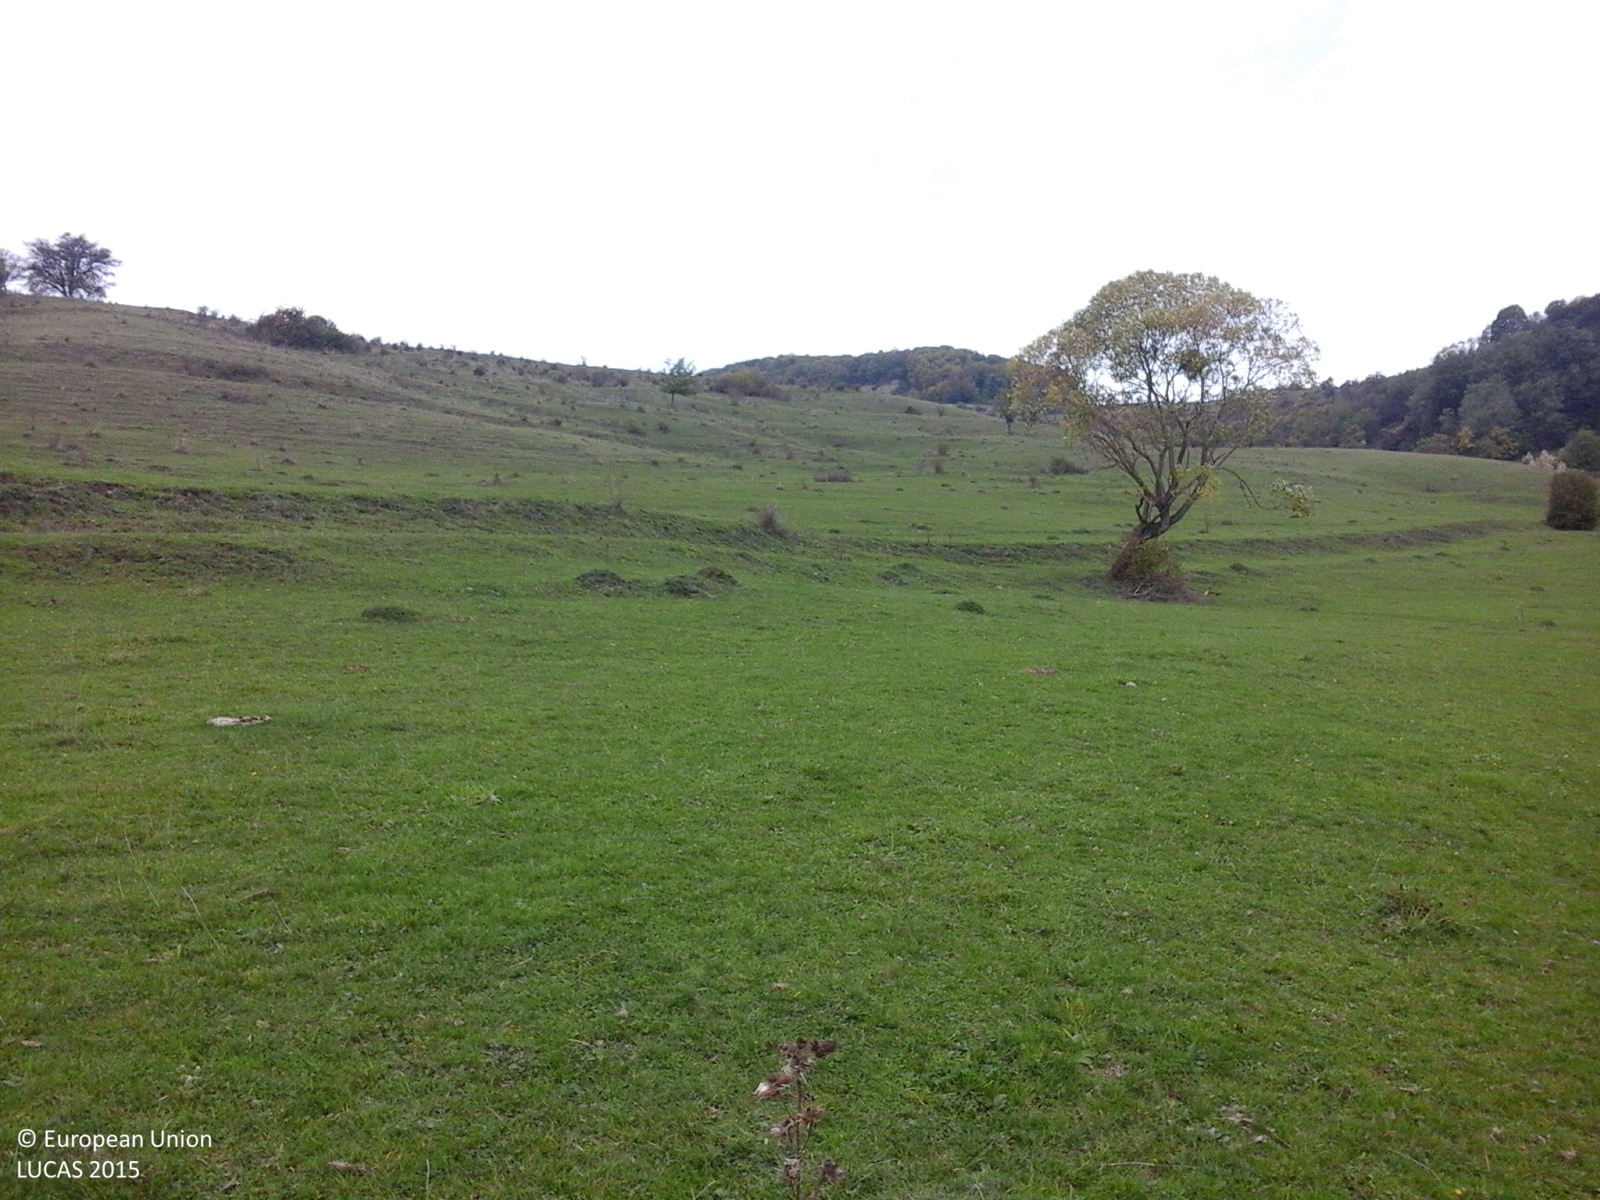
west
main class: Grassland
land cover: Grassland without tree/shrub cover
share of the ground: > 75 %
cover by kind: herbaceous plants 100 %
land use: Agriculture (excluding fallow land and kitchen gardens)
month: October
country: RO
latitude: 46.3859
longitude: 25.1178
